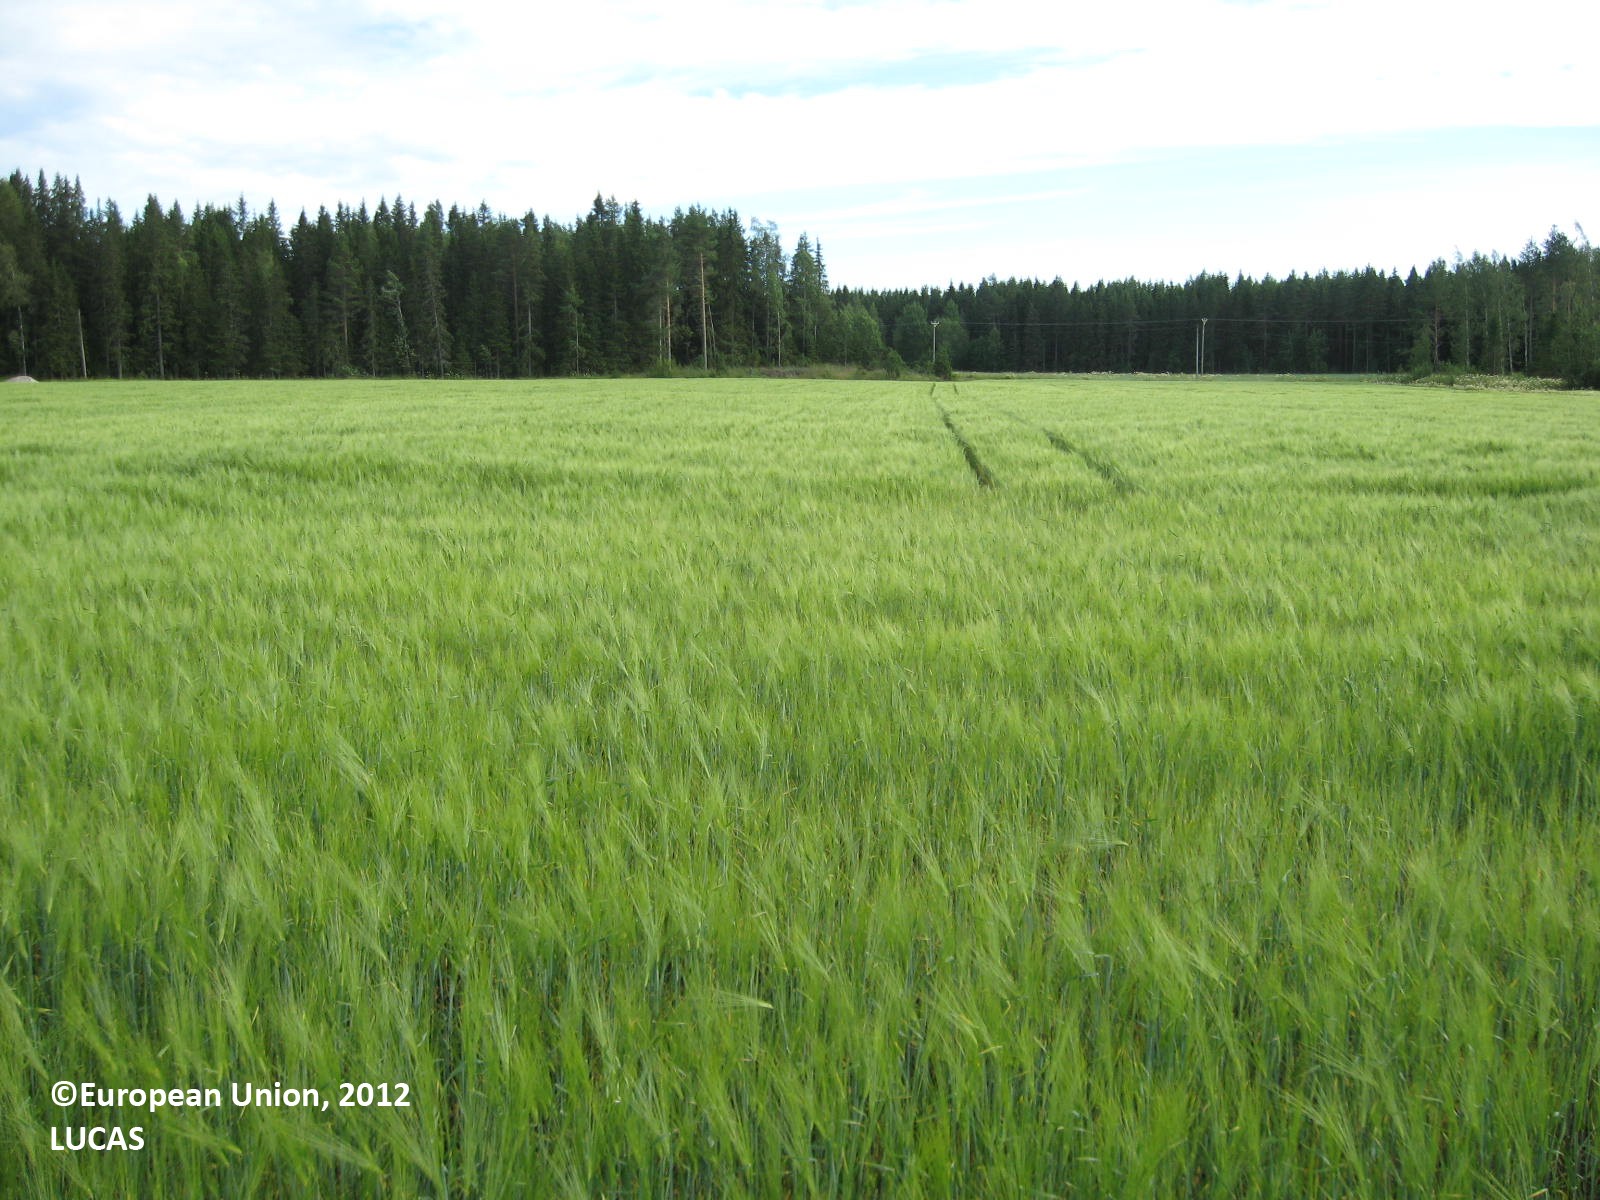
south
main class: Cropland
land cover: Barley
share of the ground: > 75 %
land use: Agriculture (excluding fallow land and kitchen gardens)
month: July
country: FI
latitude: 62.2199
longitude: 21.5664
